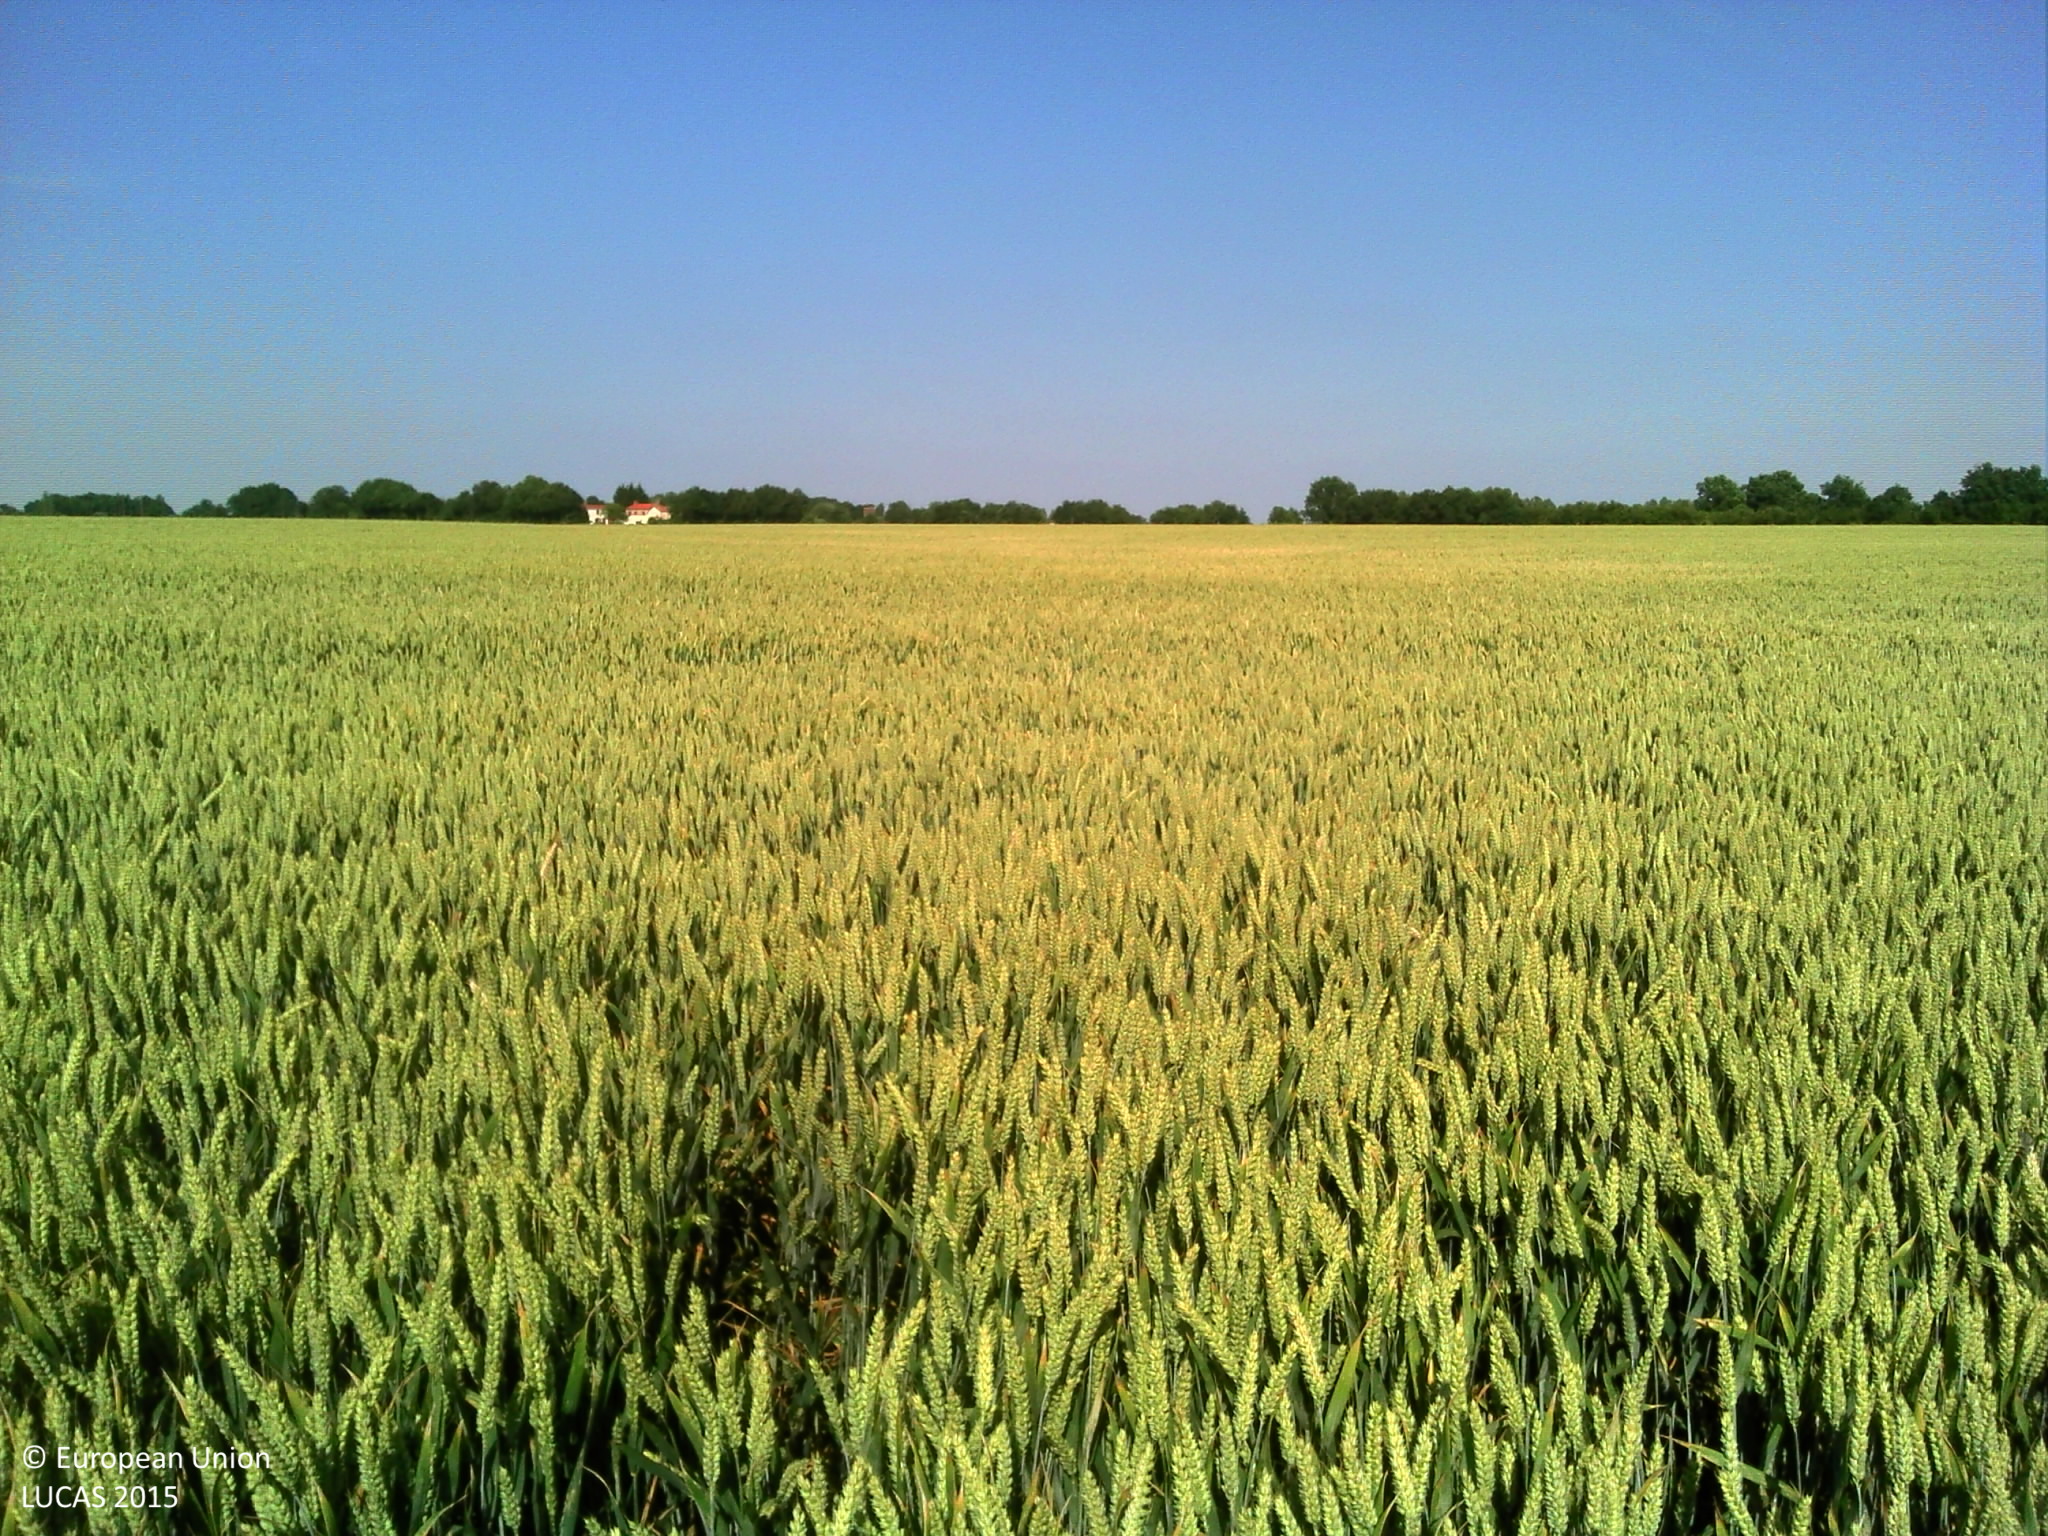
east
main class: Cropland
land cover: Common wheat
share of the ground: > 75 %
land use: Agriculture (excluding fallow land and kitchen gardens)
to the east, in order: Common wheat; Ditches and canals; Grass margins; Tracks; Grass margins; Common wheat
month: June
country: FR
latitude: 46.8887
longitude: -1.3641
